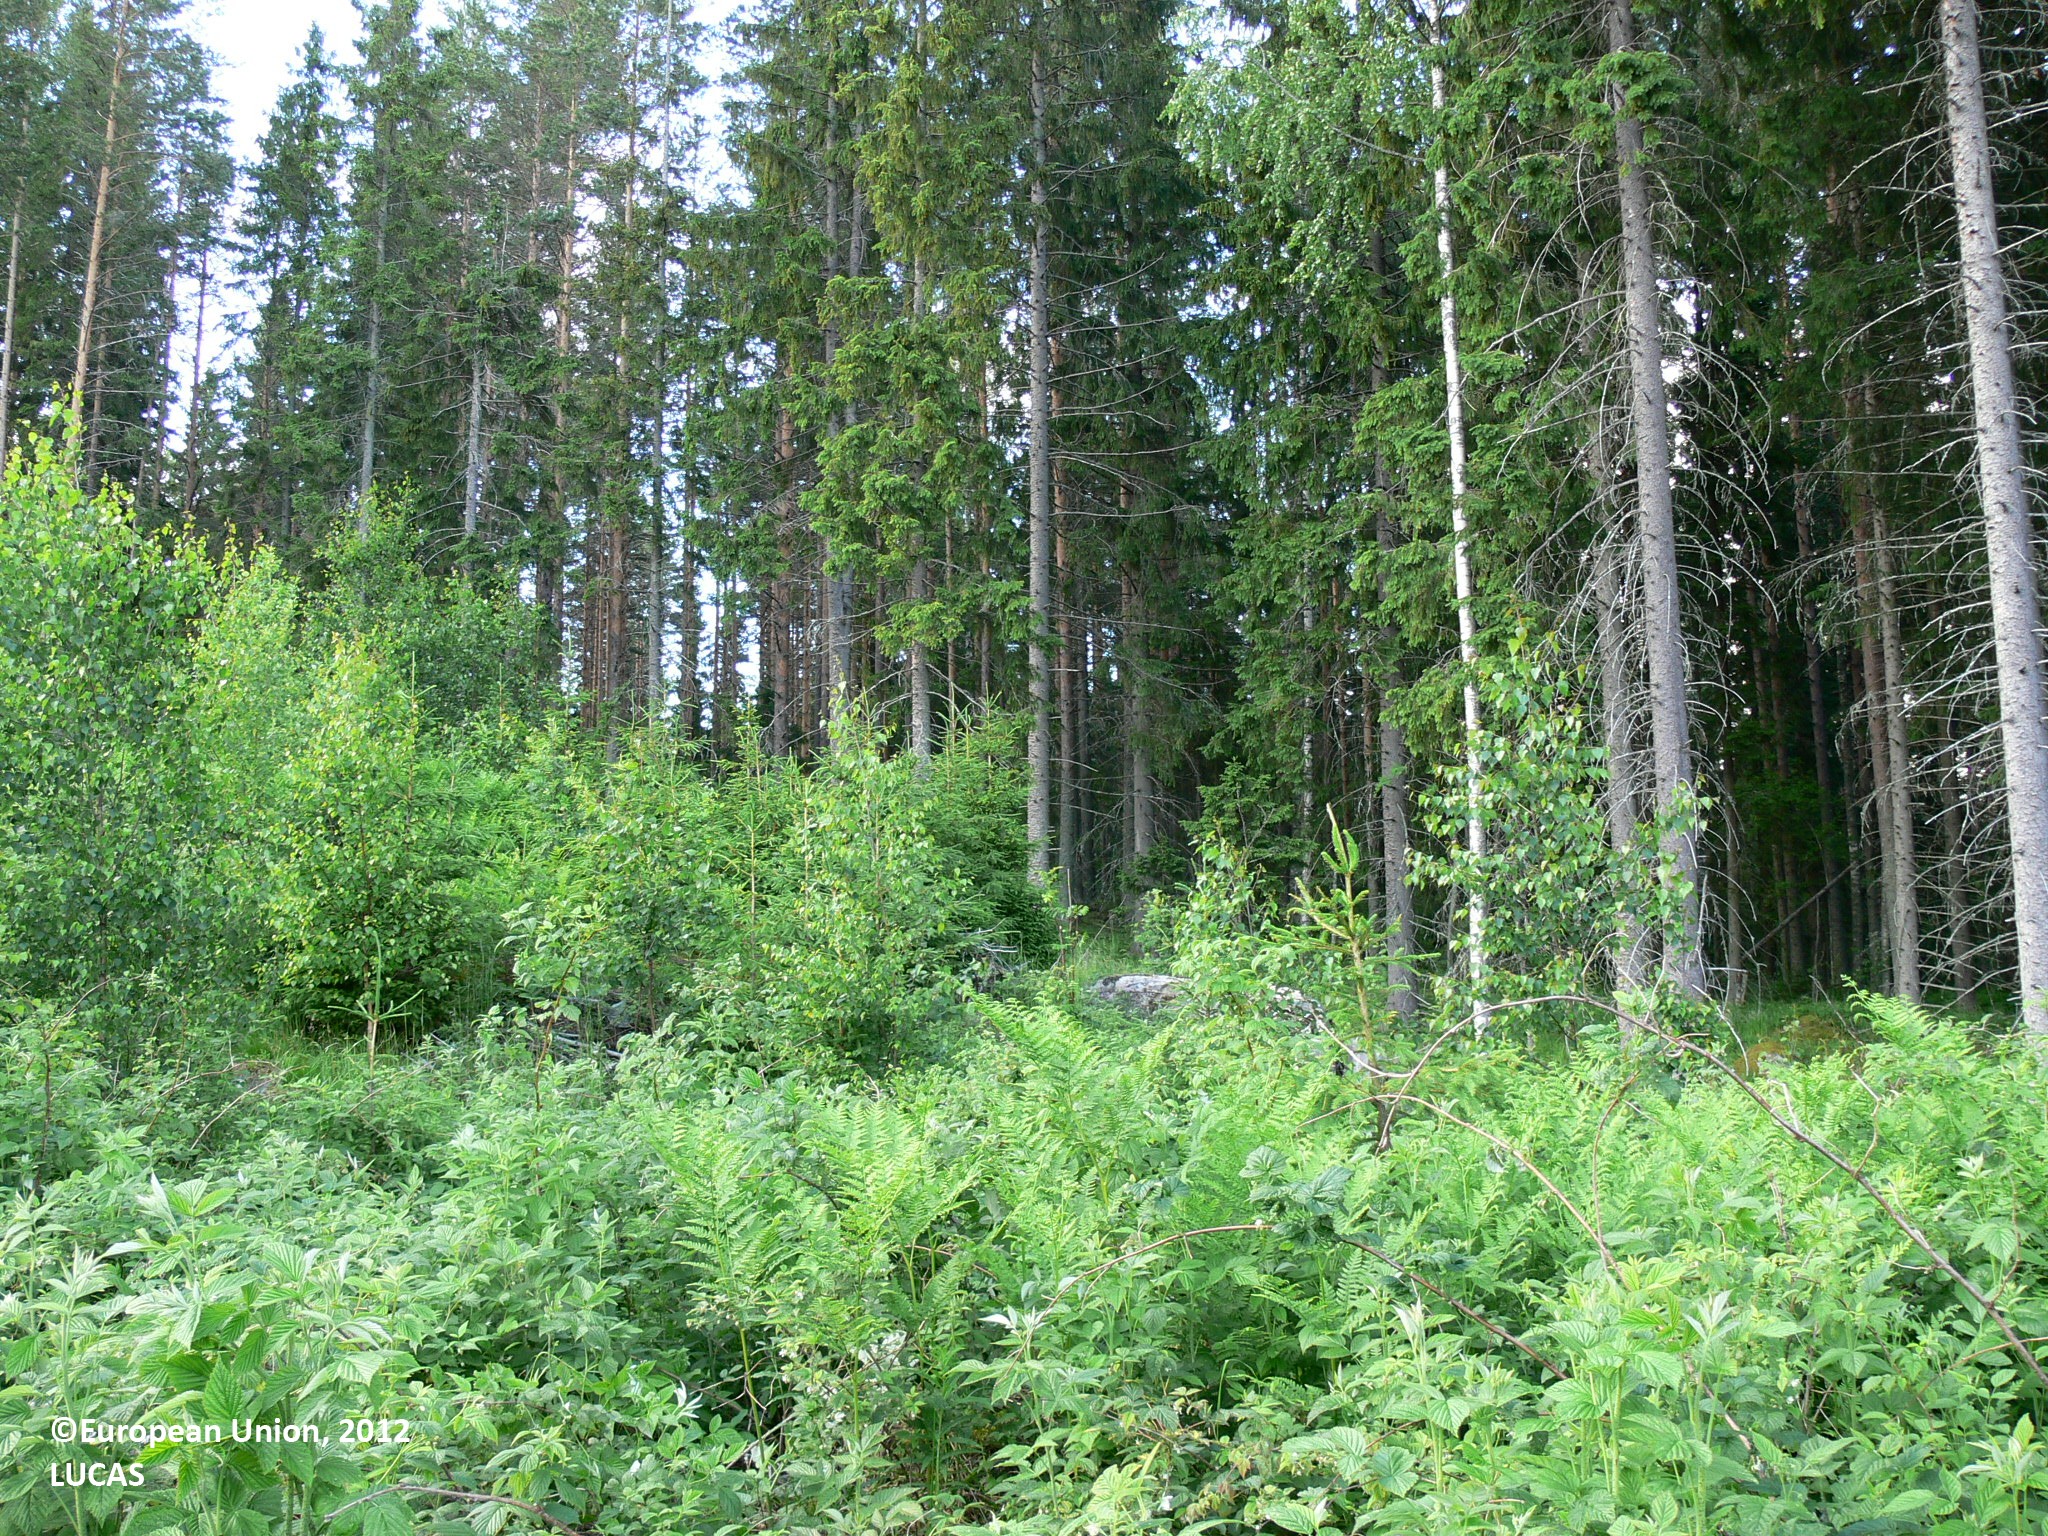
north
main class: Woodland
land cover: Spruce dominated mixed woodland
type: boreal forest
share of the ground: 25 - 50 %
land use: Forestry
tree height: < 5 m
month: June
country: FI
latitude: 62.3617
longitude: 29.5066
